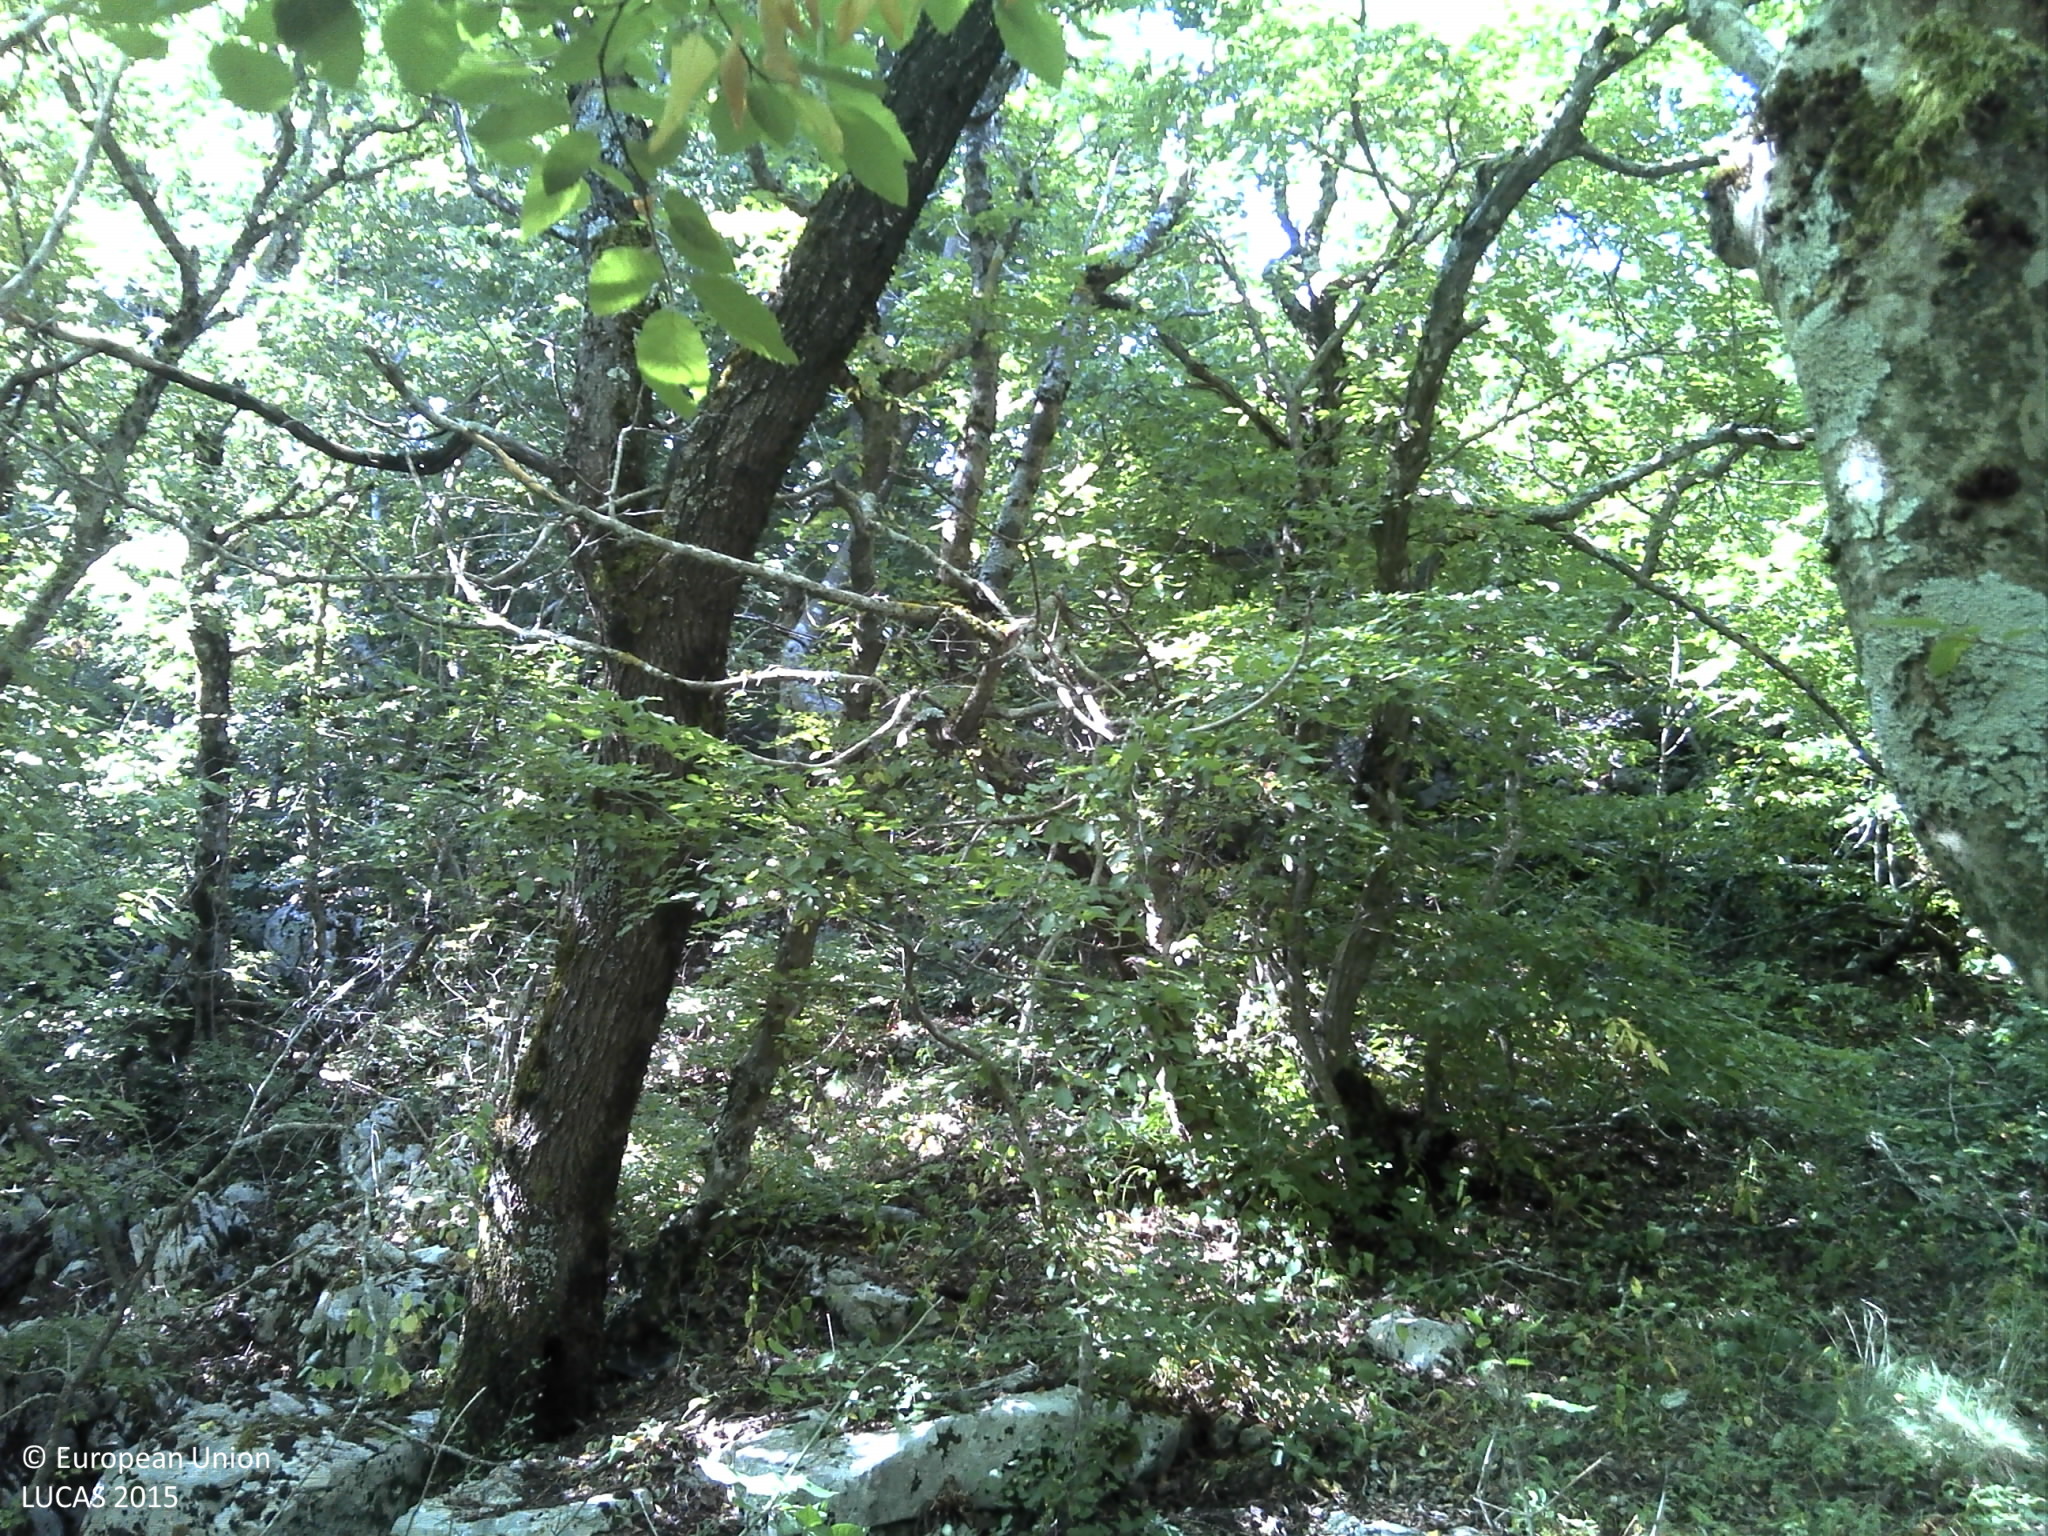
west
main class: Woodland
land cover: Broadleaved woodland
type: thermophilous deciduous forest
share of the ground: 50 - 75 %
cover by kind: broadleaved forest trees 70 %, shrubs 15 %, herbaceous plants 10 %, consolidated bare surface 5 %
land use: Semi-natural and natural areas not in use
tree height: > 5 m
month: July
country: HR
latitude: 43.5308
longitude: 17.0574
